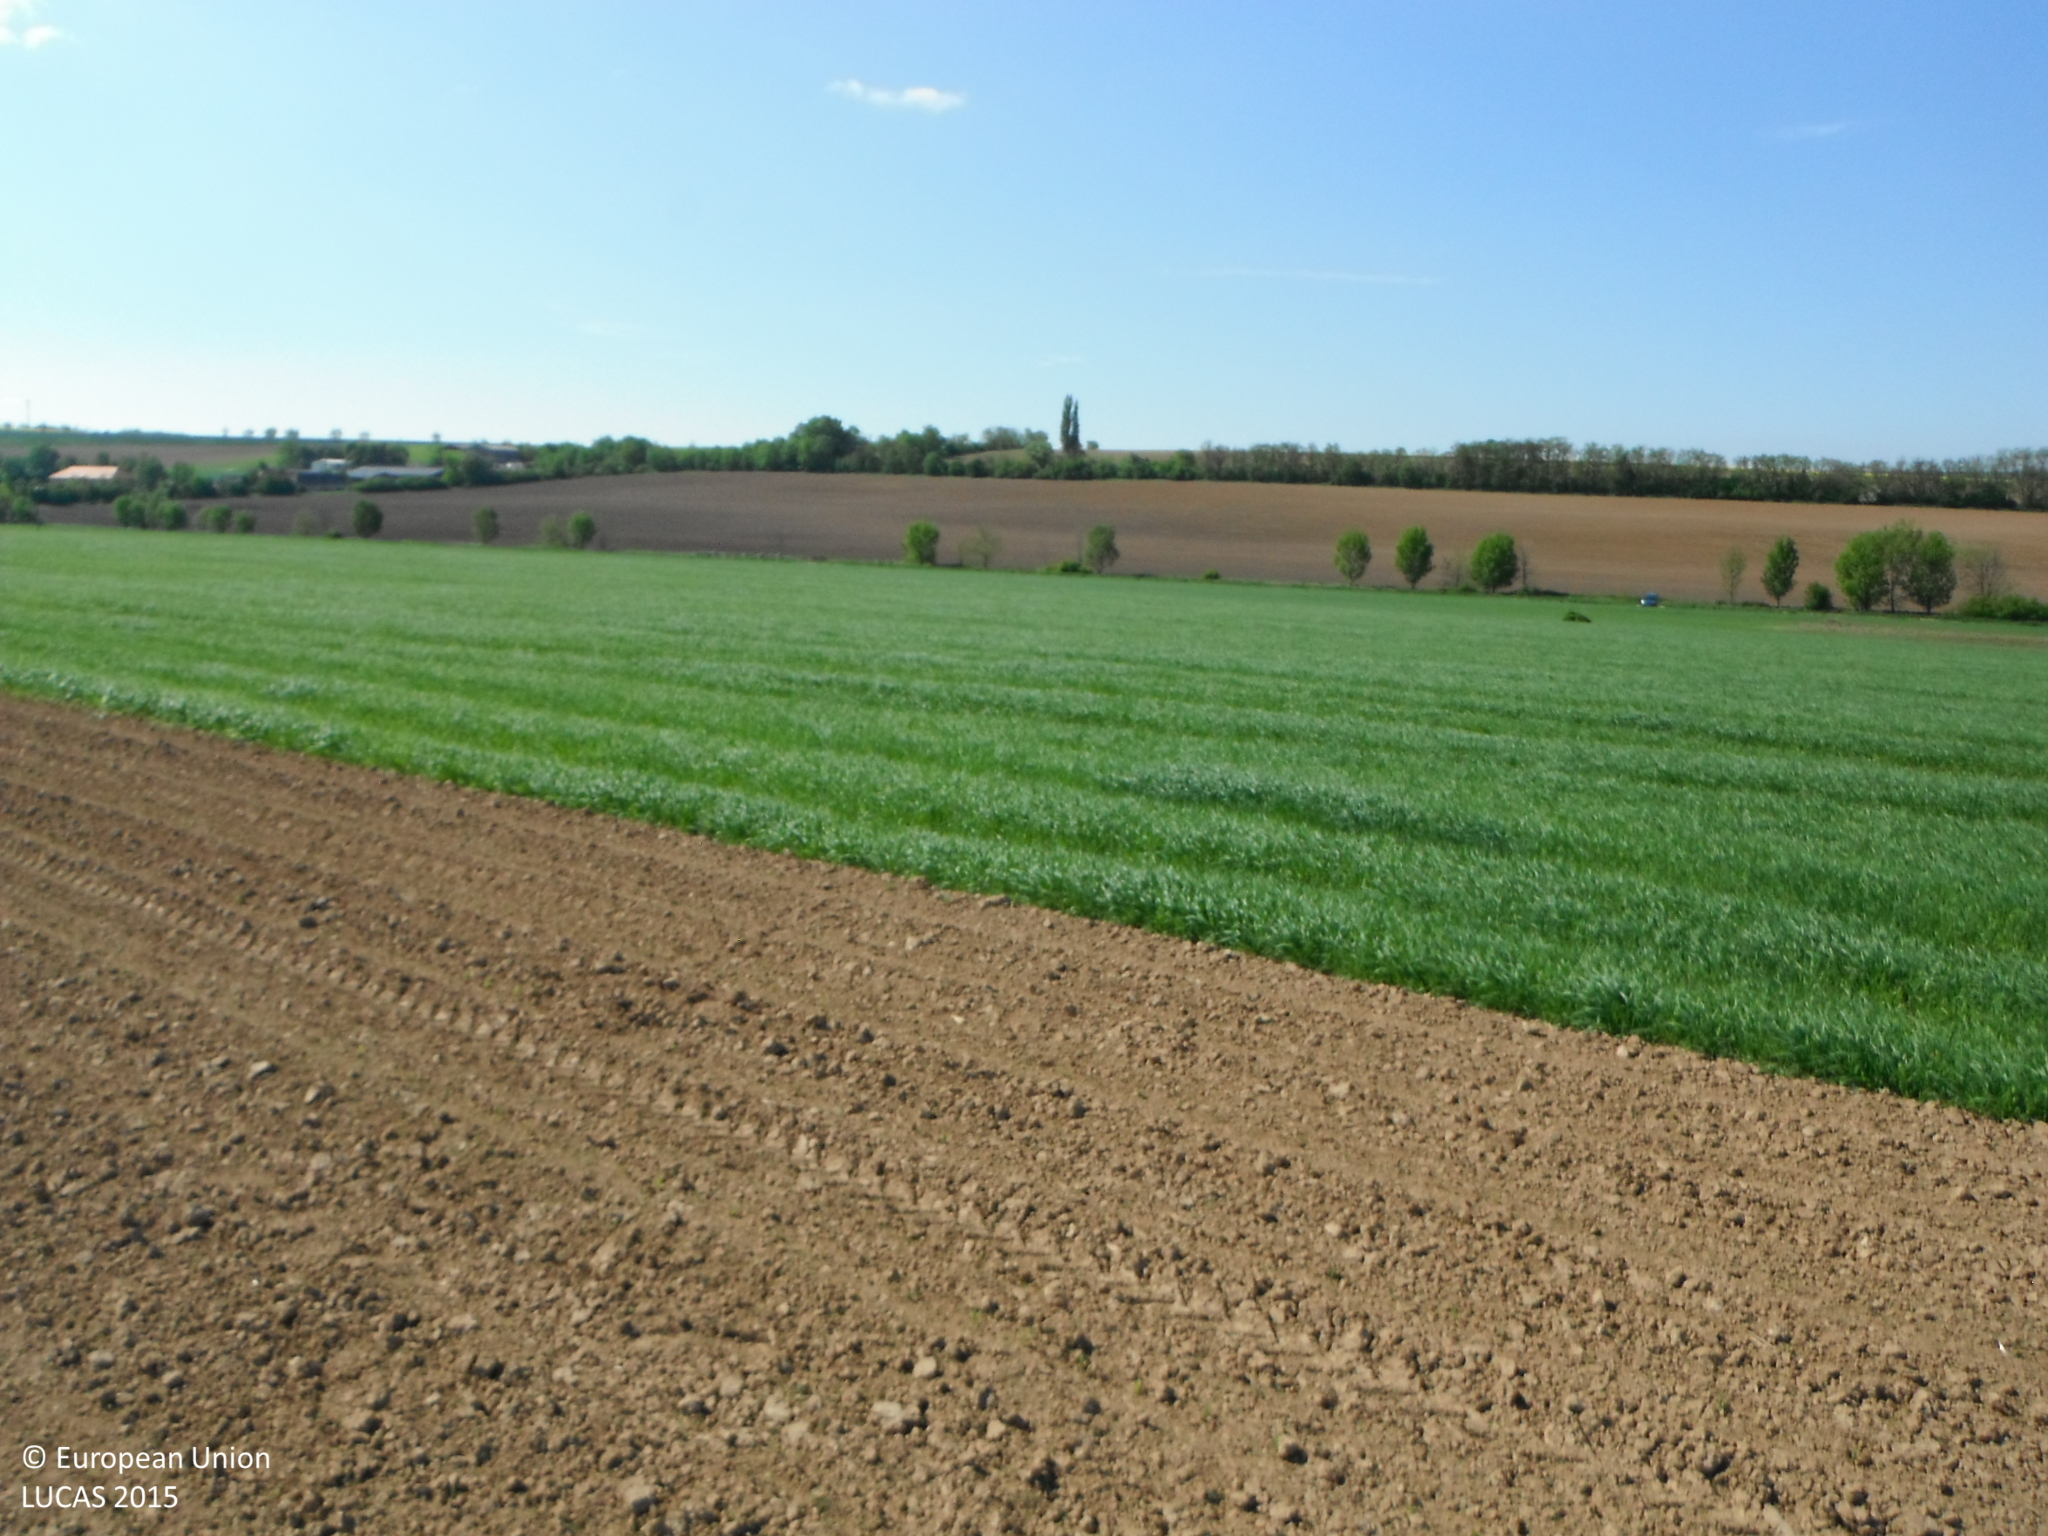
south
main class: Cropland
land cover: Maize
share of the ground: < 10 %
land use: Agriculture (excluding fallow land and kitchen gardens)
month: May
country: SK
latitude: 48.3493
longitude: 18.2324
